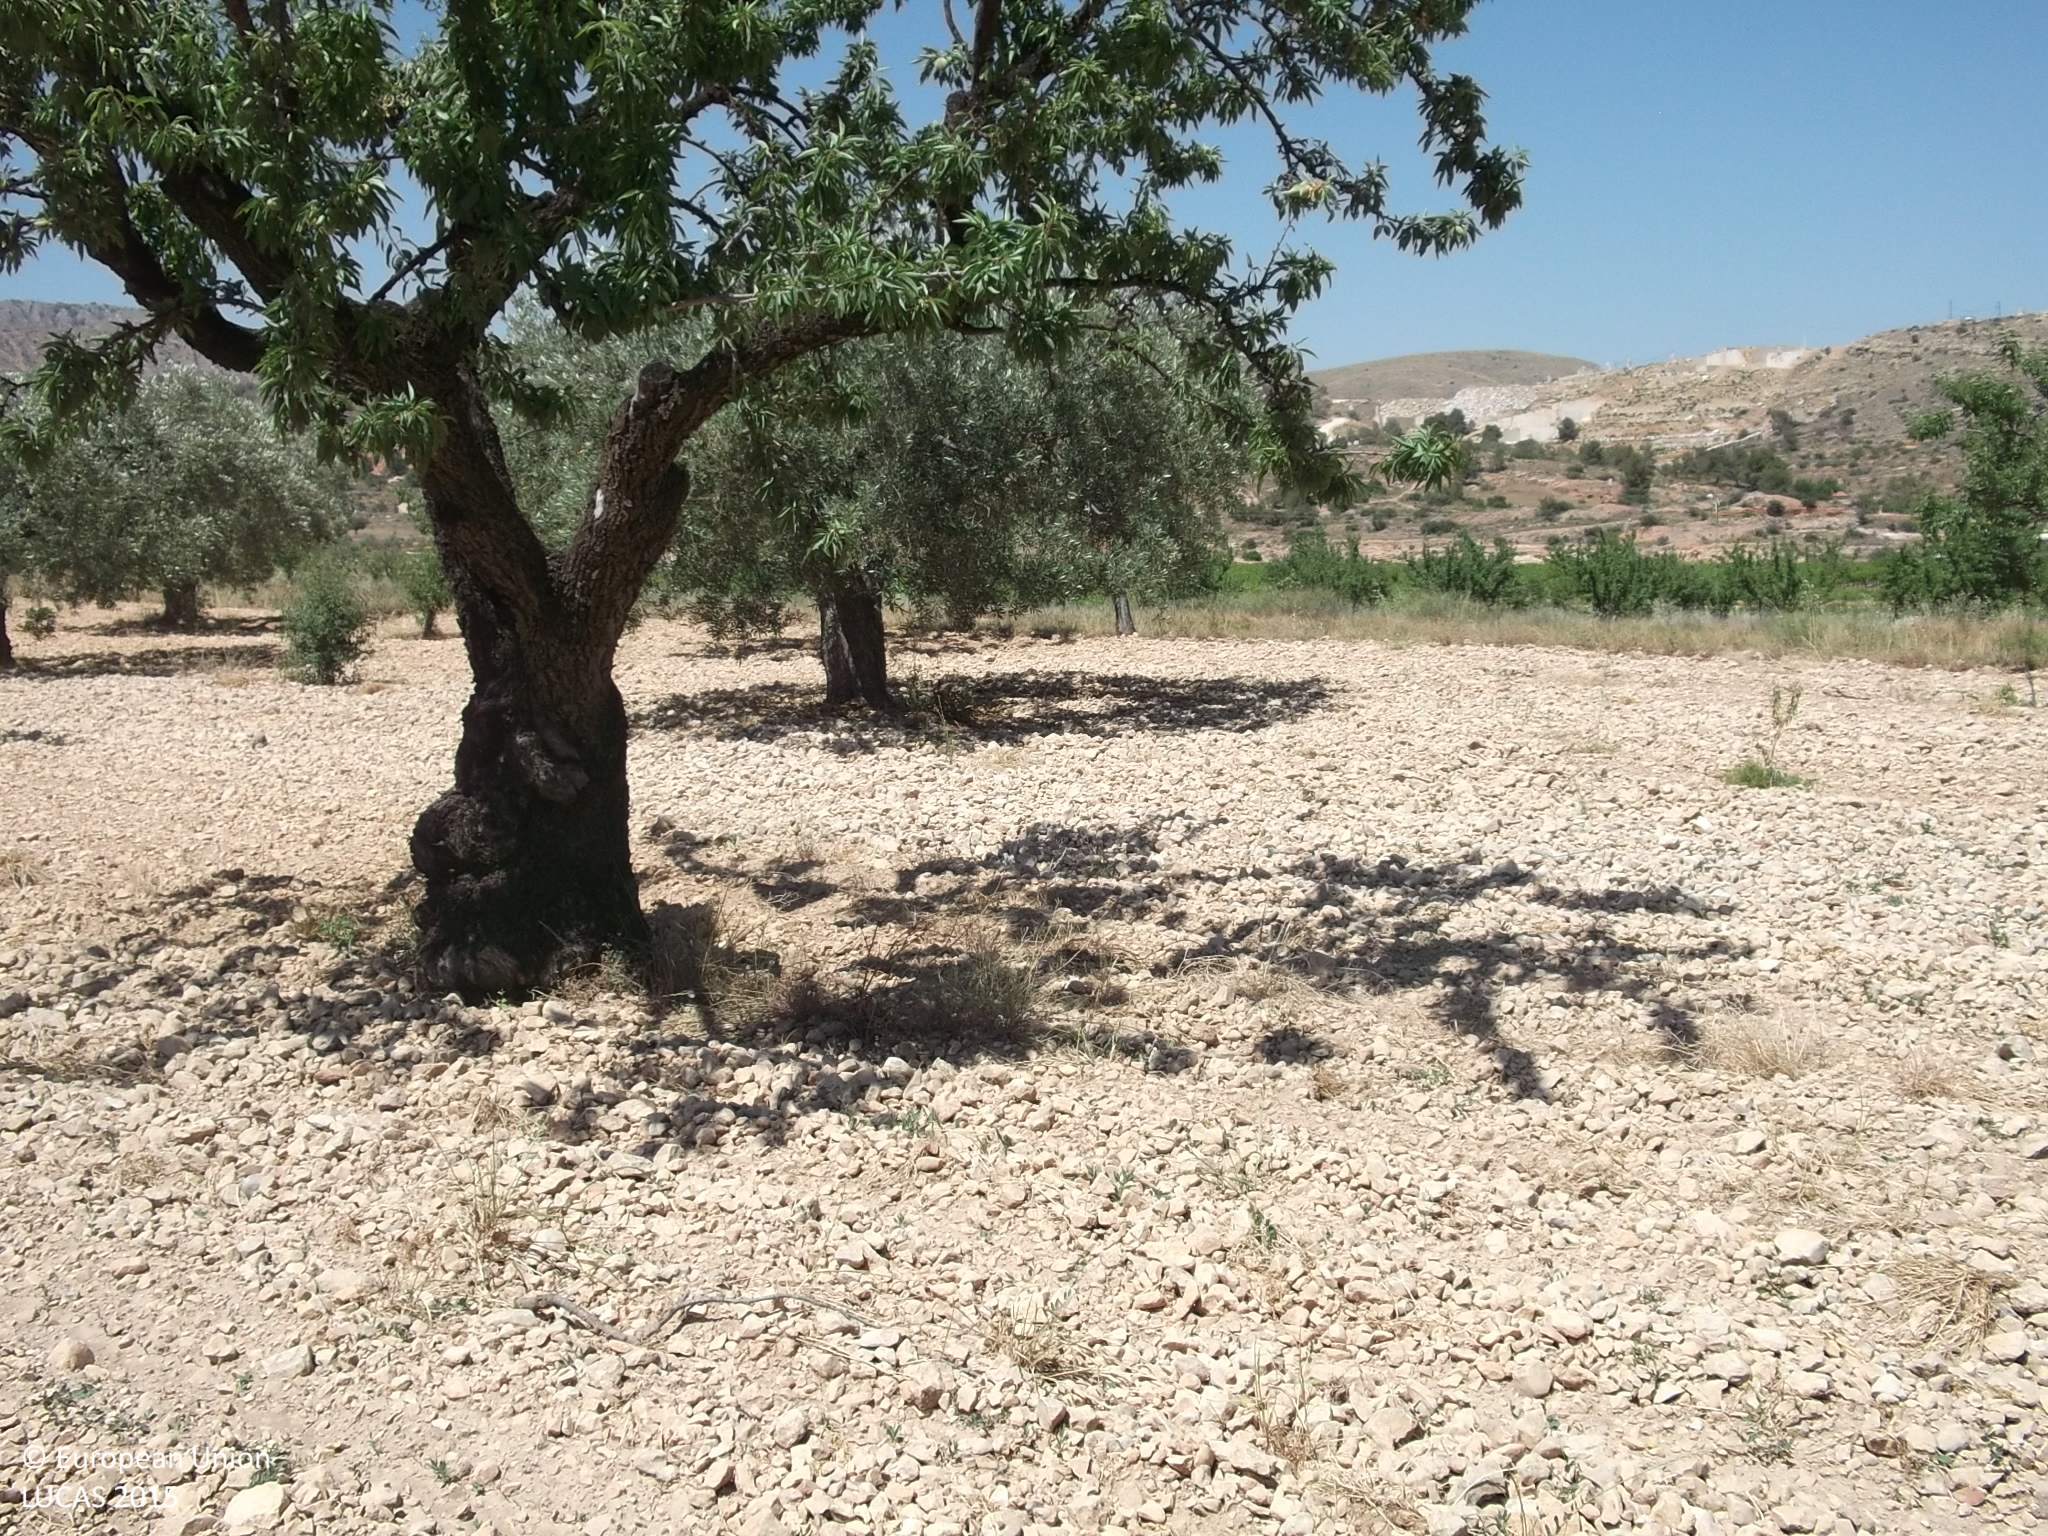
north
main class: Cropland
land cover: Nuts trees
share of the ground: 10 - 25 %
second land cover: Other bare soil
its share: > 75 %
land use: Agriculture (excluding fallow land and kitchen gardens)
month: May
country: ES
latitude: 38.3421
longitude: -0.9137
